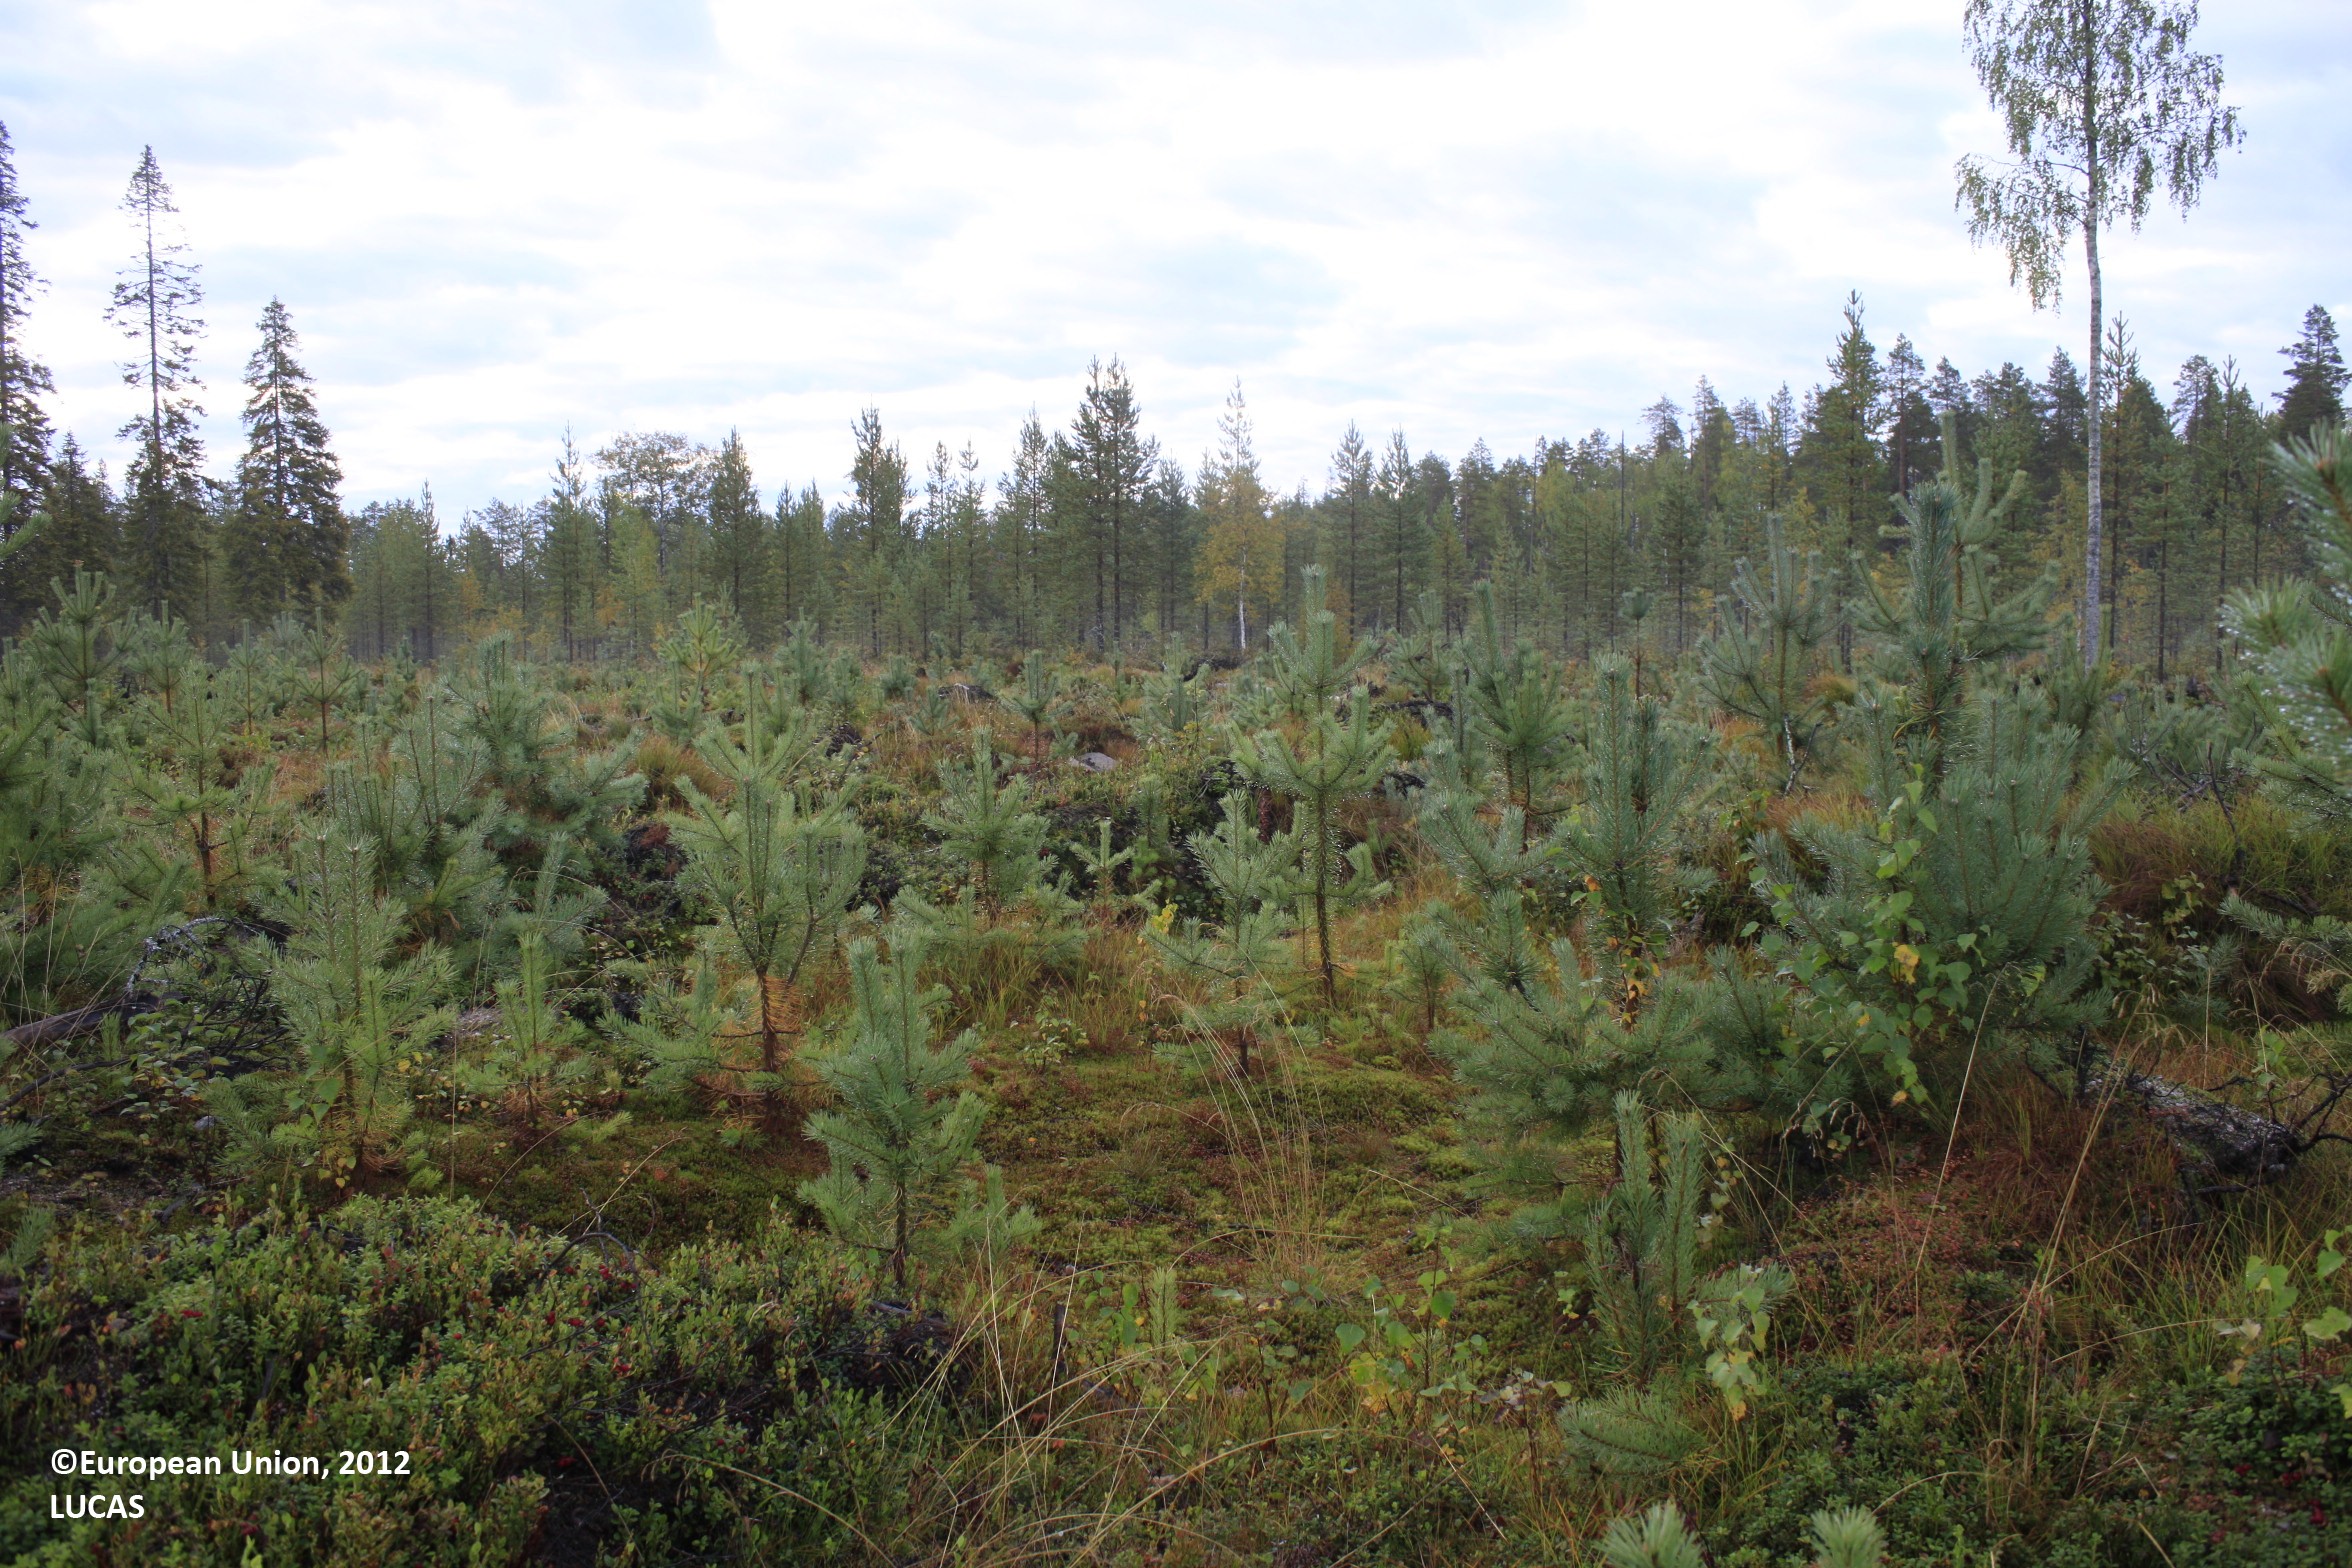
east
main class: Woodland
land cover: Pine dominated coniferous woodland
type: boreal forest
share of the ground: 25 - 50 %
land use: Forestry
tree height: < 5 m
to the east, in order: Pine dominated coniferous woodland; Ditches and canals; Pine dominated mixed woodland; Ditches and canals; Paved roads, cycling and walking lanes; Ditches and canals; Pine dominated mixed woodland; Peatbogs
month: September
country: FI
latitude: 65.6193
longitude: 26.7137
